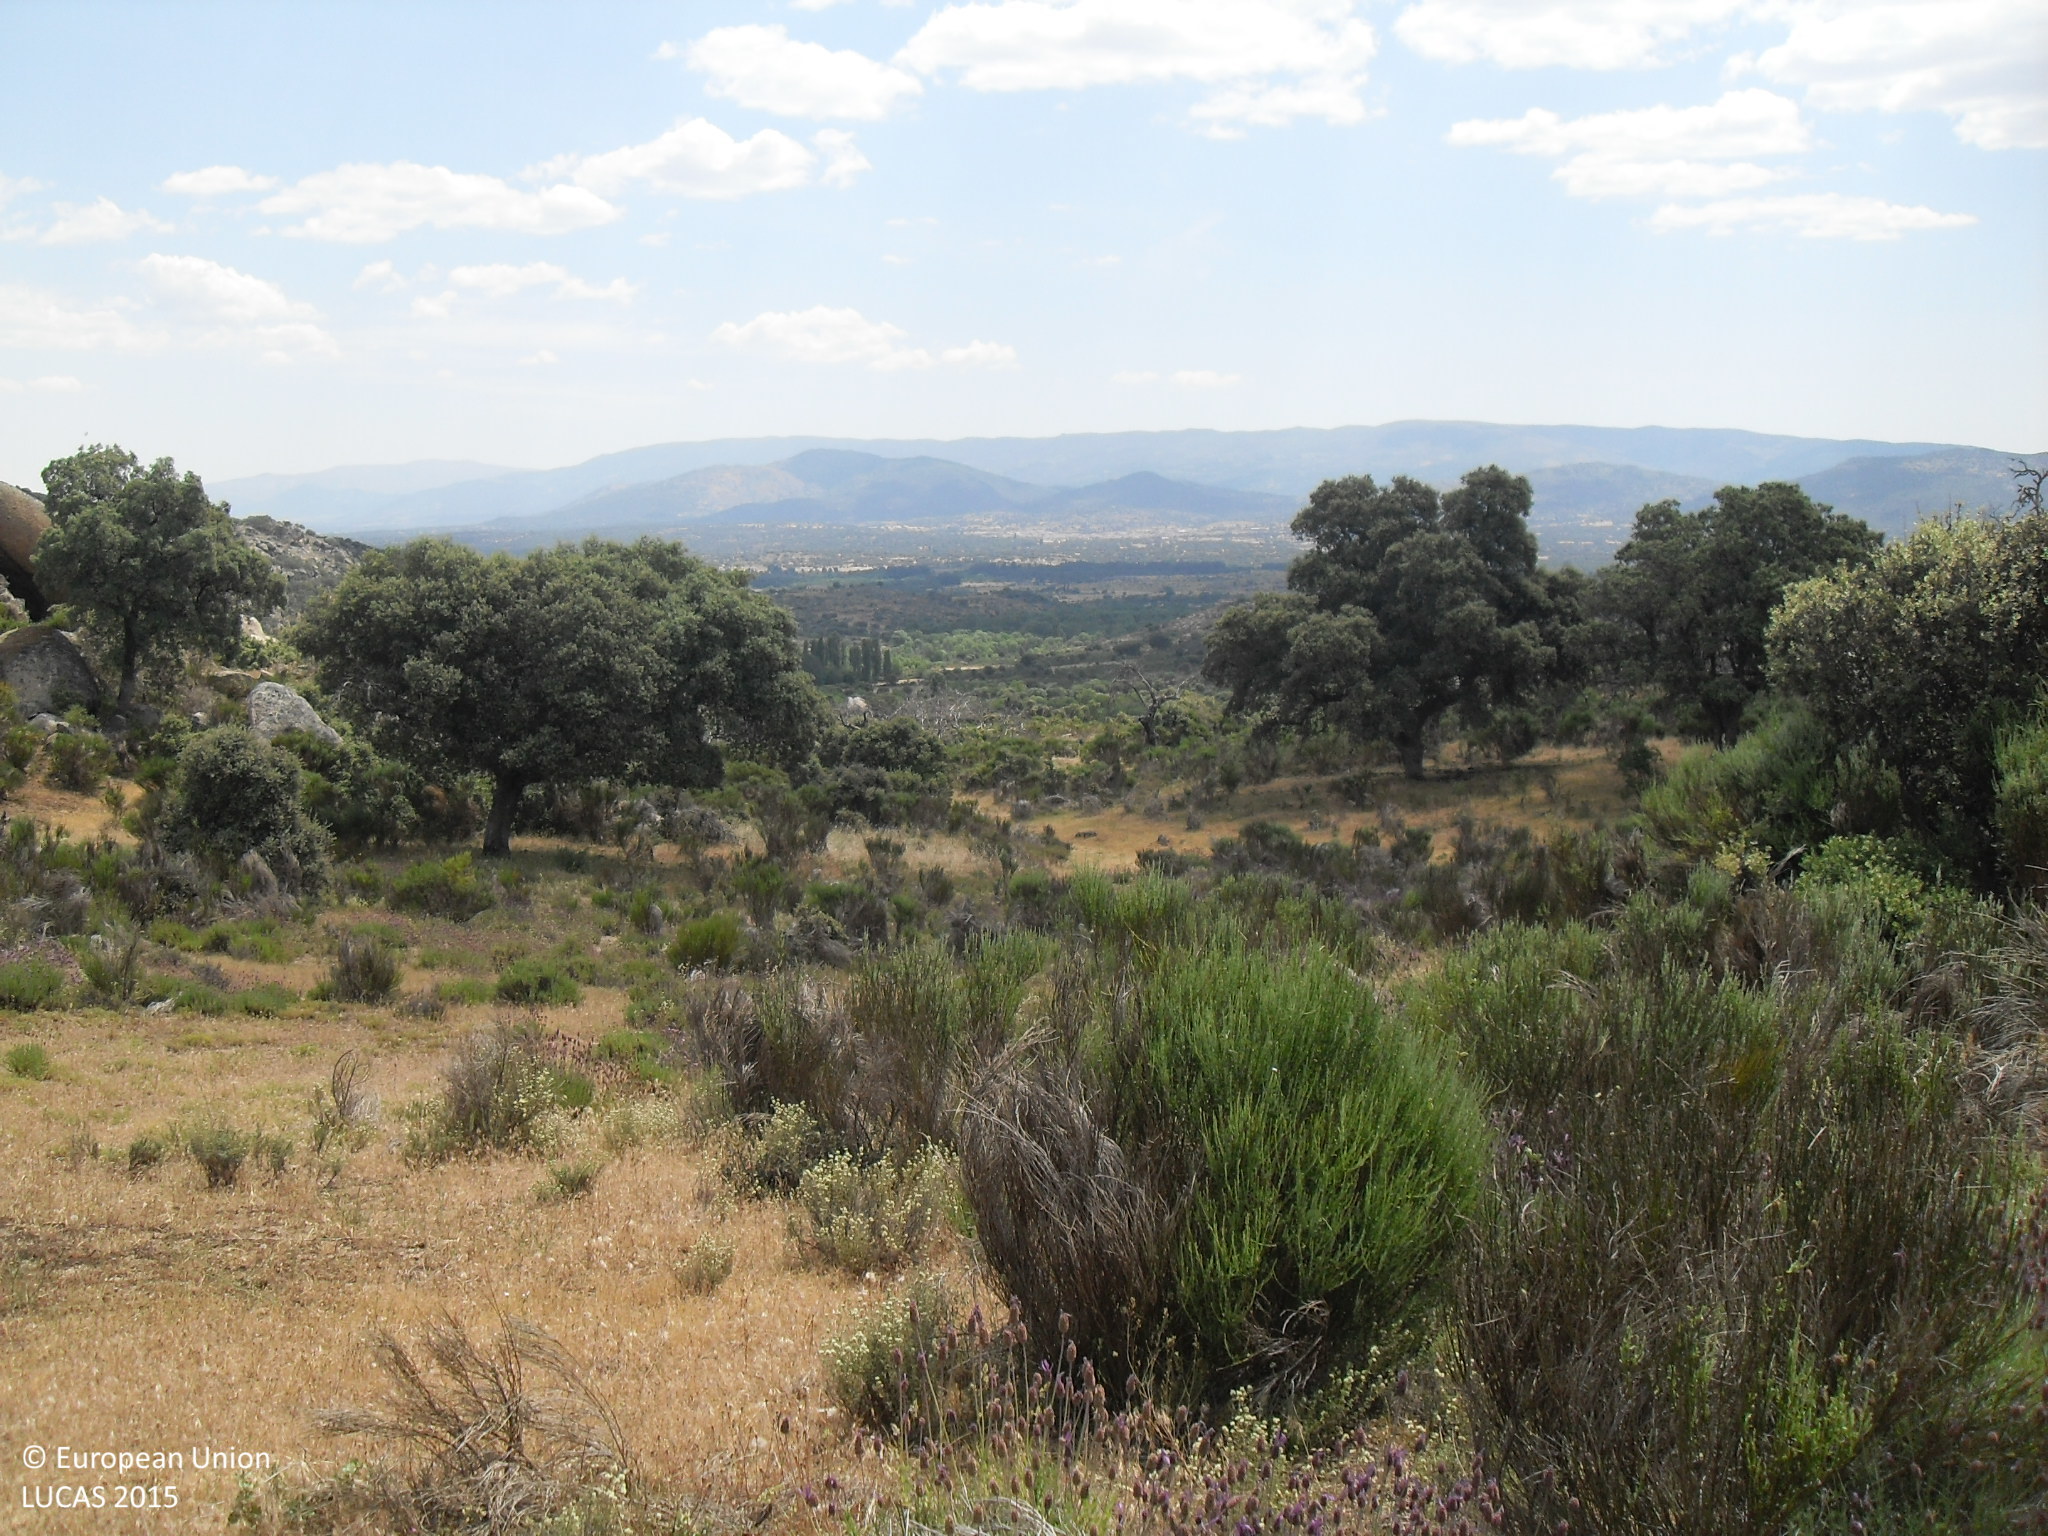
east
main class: Shrubland
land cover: Shrubland without tree cover
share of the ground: > 75 %
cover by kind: shrubs 60 %, herbaceous plants 40 %
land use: Abandoned areas
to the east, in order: Shrubland without tree cover; Dry stone walls; Shrubland without tree cover; Dry stone walls; Shrubland without tree cover
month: June
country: ES
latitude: 40.4491
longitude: -5.5729
